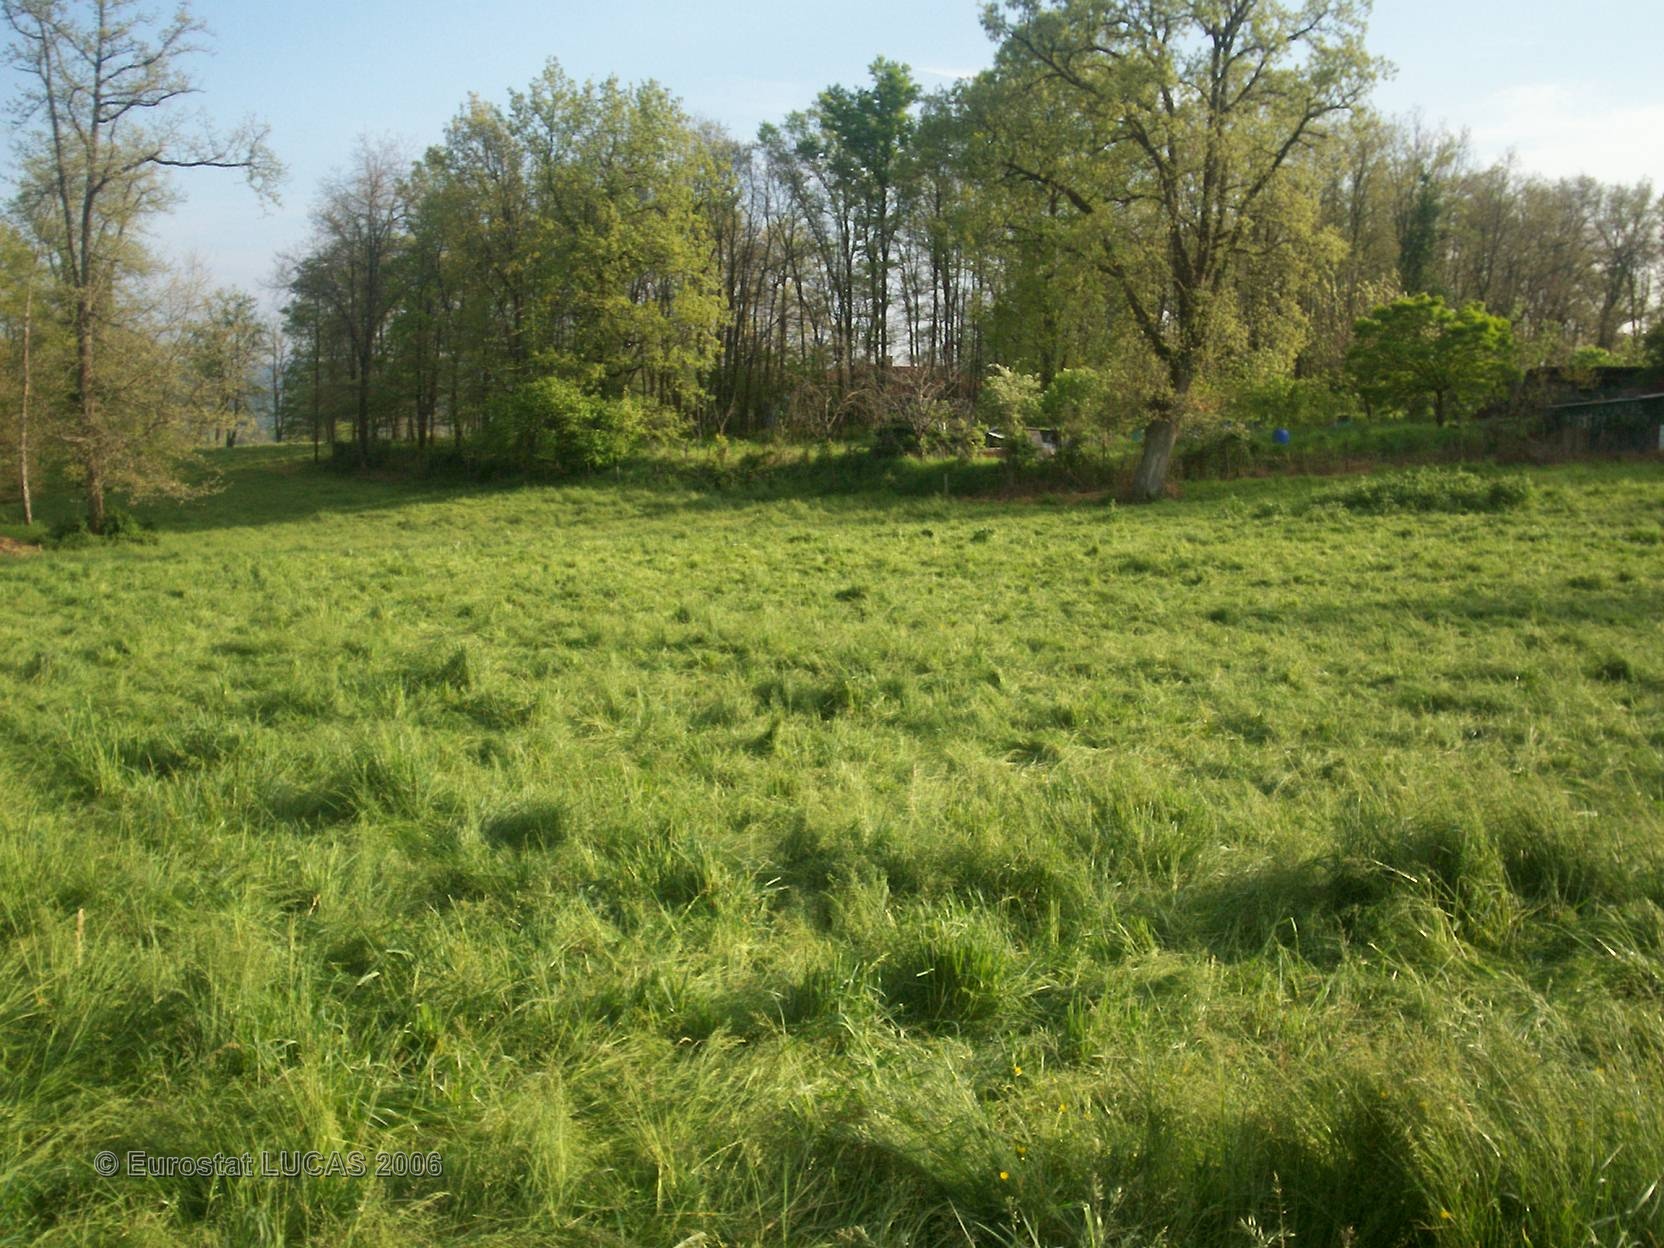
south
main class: Grassland
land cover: Grassland without tree/shrub cover
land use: Agriculture (excluding fallow land and kitchen gardens)
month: April
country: FR
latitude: 43.7868
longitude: 1.9889
